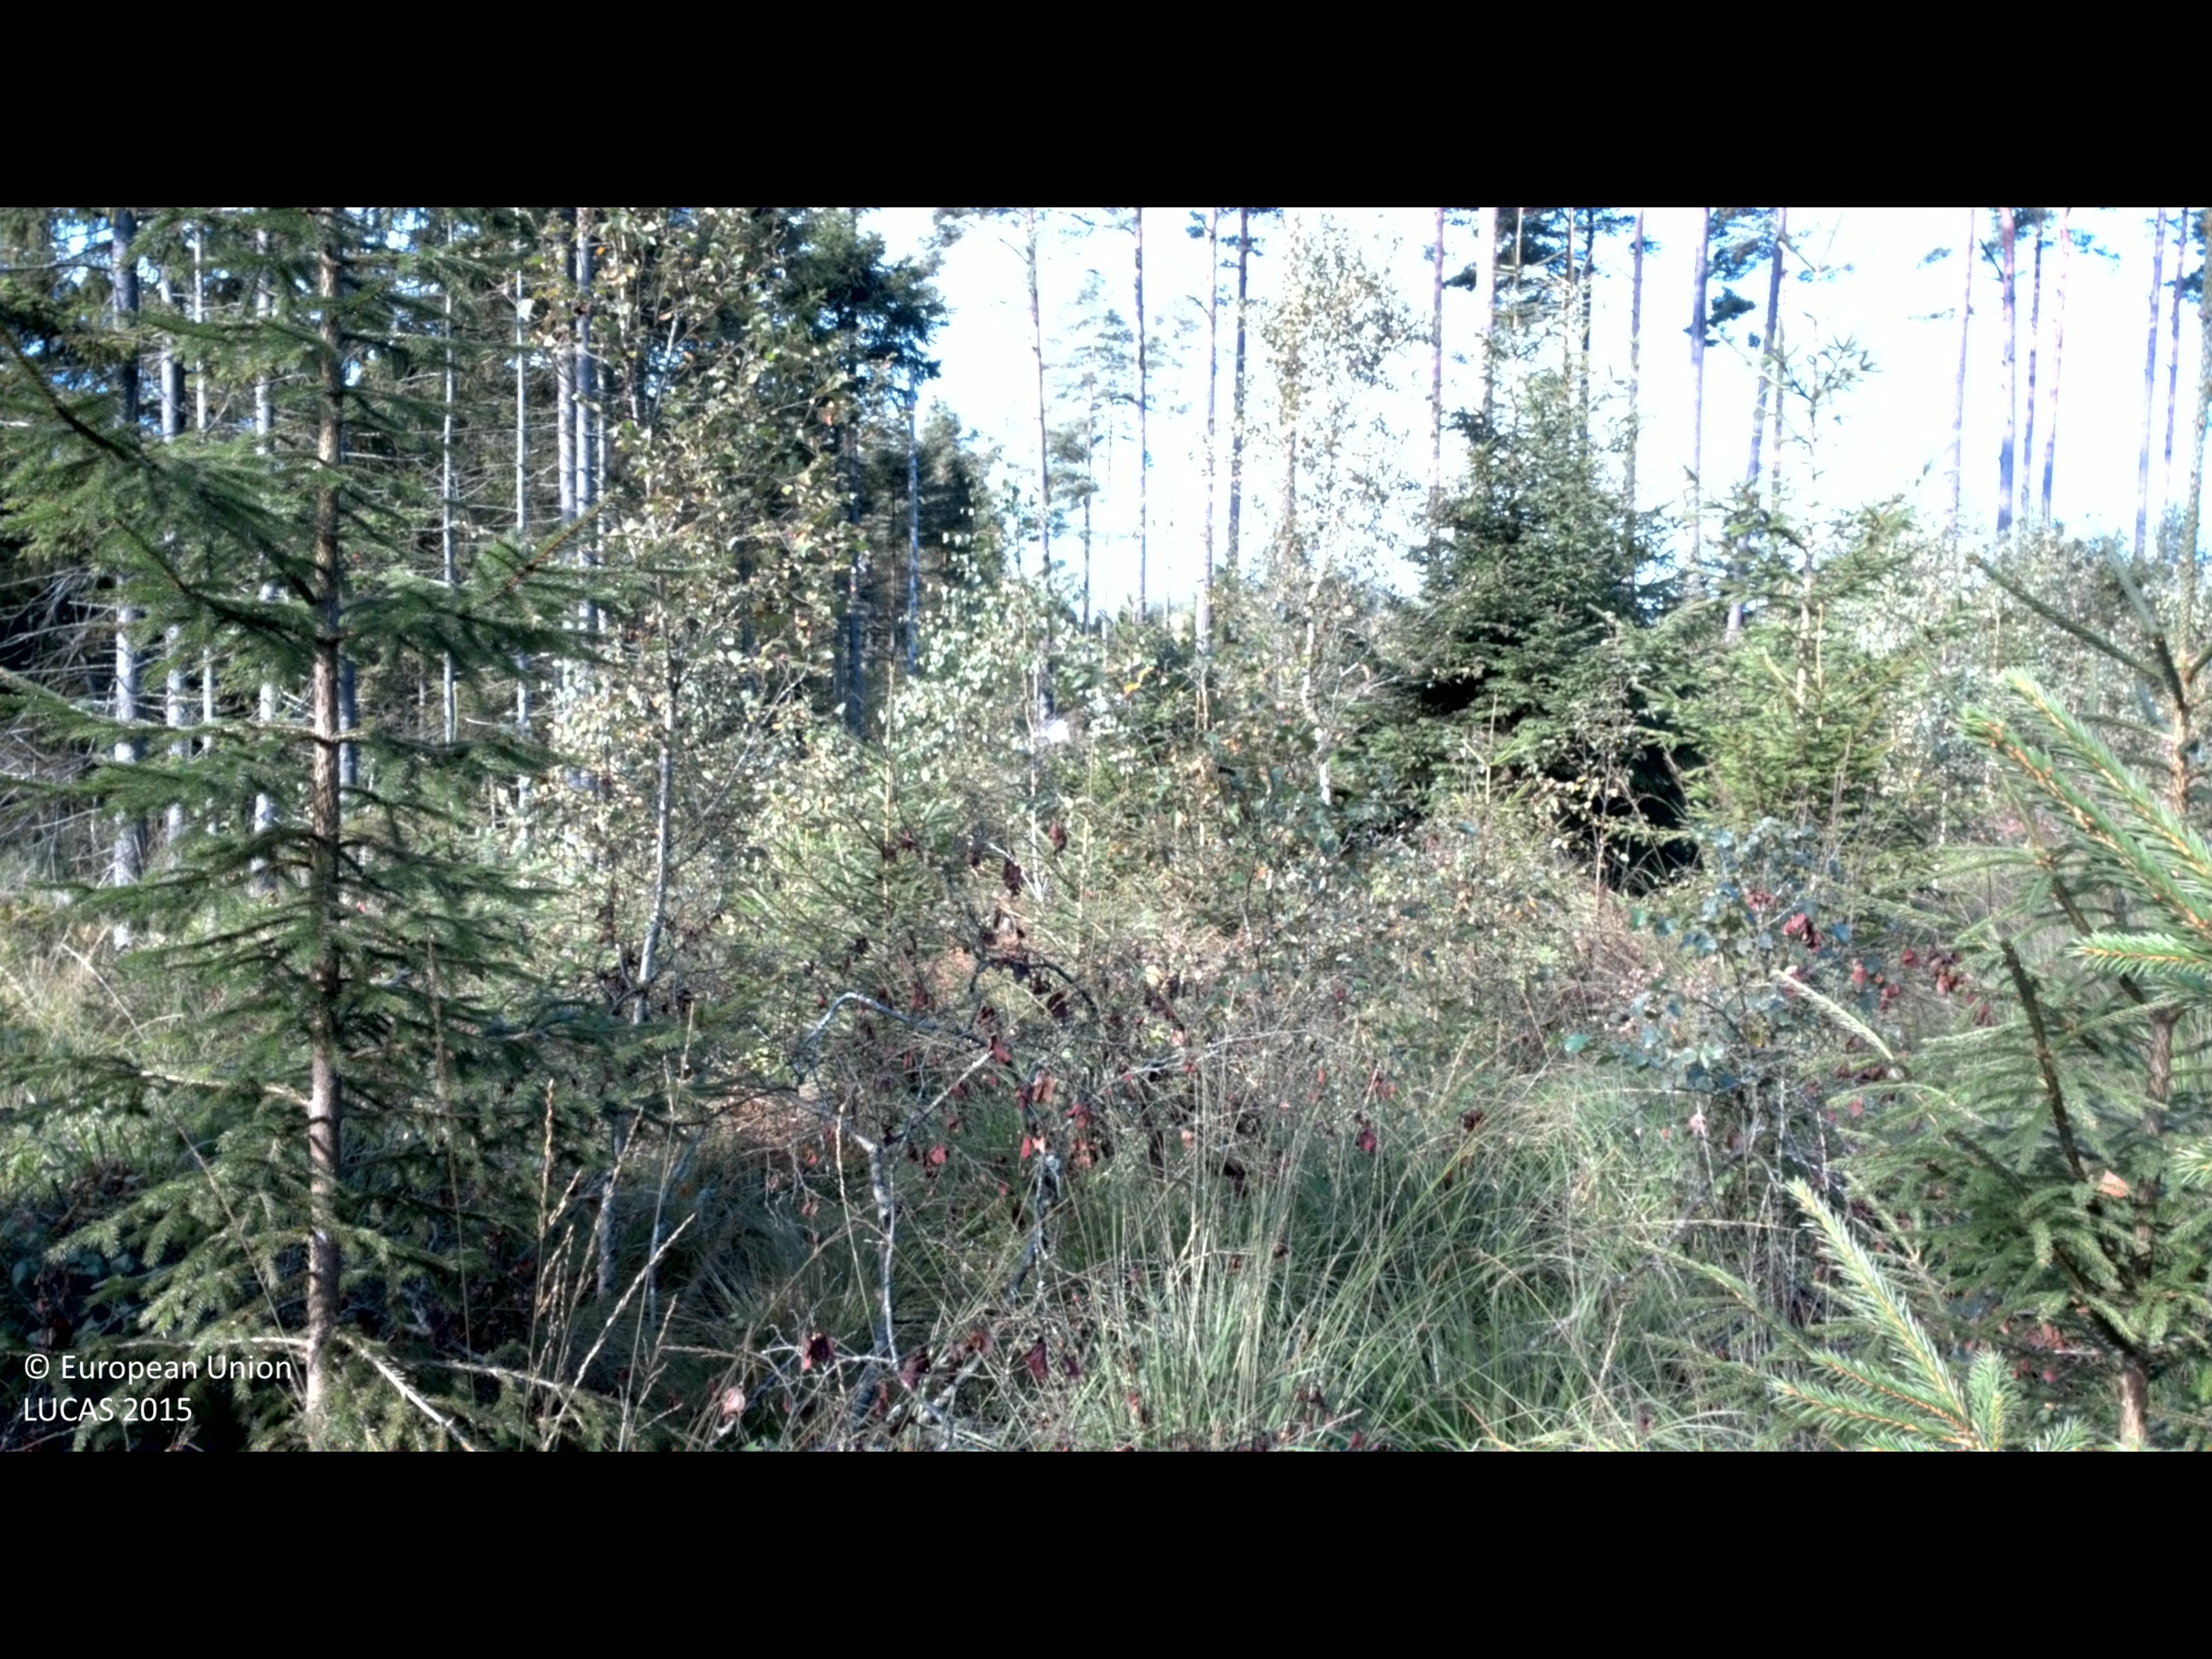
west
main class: Woodland
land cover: Spruce dominated mixed woodland
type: boreal forest
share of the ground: 50 - 75 %
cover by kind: coniferous forest trees 35 %, broadleaved forest trees 25 %, shrubs 20 %, herbaceous plants 20 %
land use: Forestry
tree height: < 5 m
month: September
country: SE
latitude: 56.8514
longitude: 13.1285
